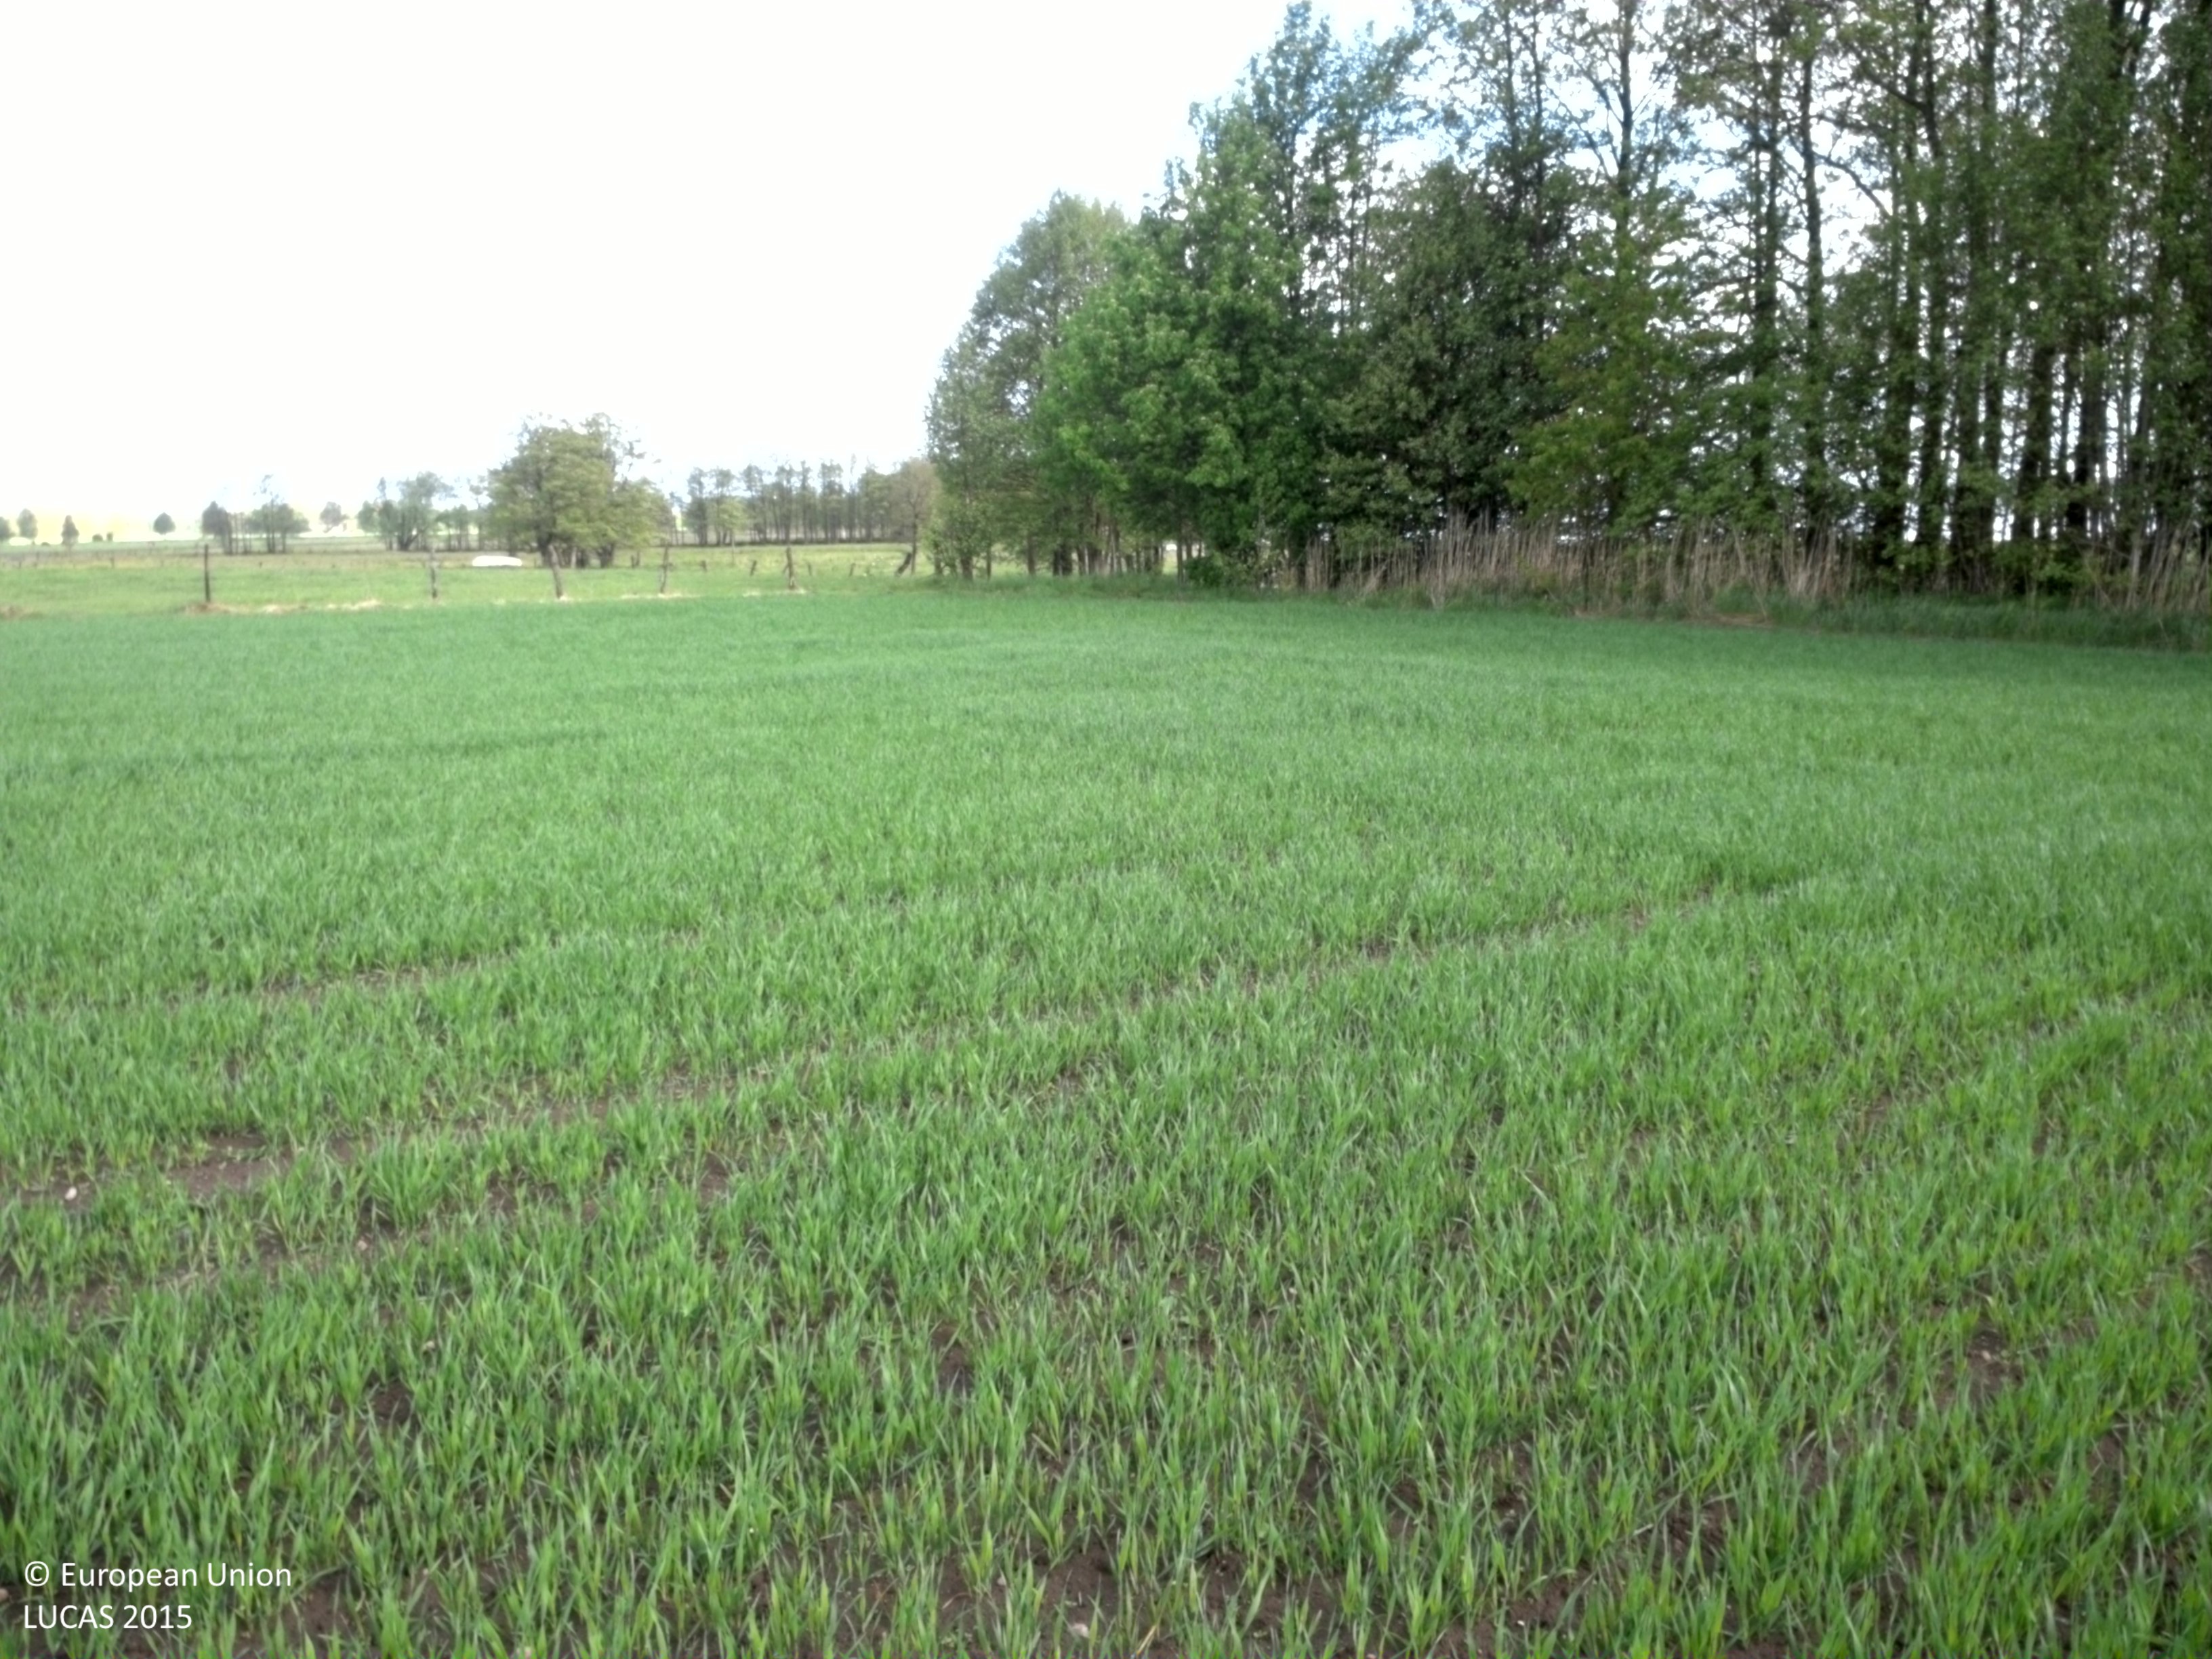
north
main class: Cropland
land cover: Oats
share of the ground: 50 - 75 %
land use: Agriculture (excluding fallow land and kitchen gardens)
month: June
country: SE
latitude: 56.7181
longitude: 14.5885
